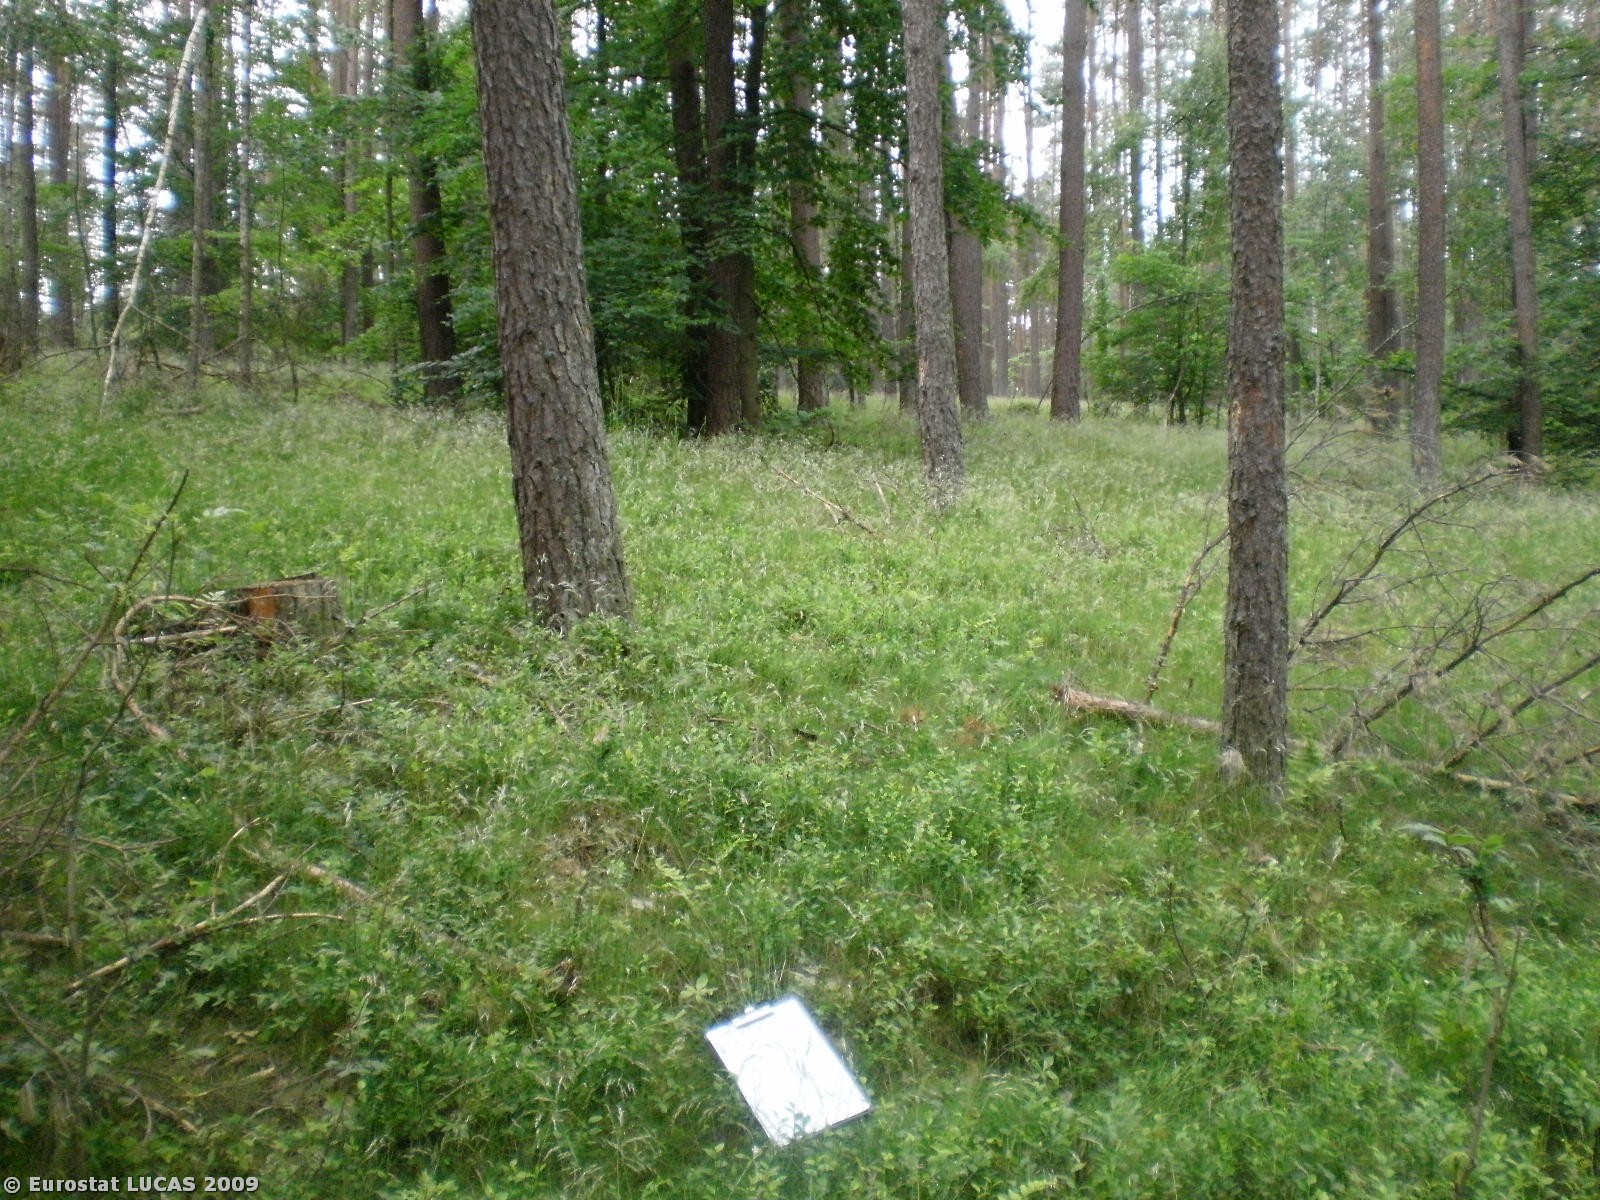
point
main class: Woodland
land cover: Coniferous woodland
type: hemiboreal forest and nemoral coniferous forest and mixed broadleaved-coniferous forest
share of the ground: > 75 %
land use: Forestry
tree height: > 5 m
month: June
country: PL
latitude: 53.7584
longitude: 19.8740
